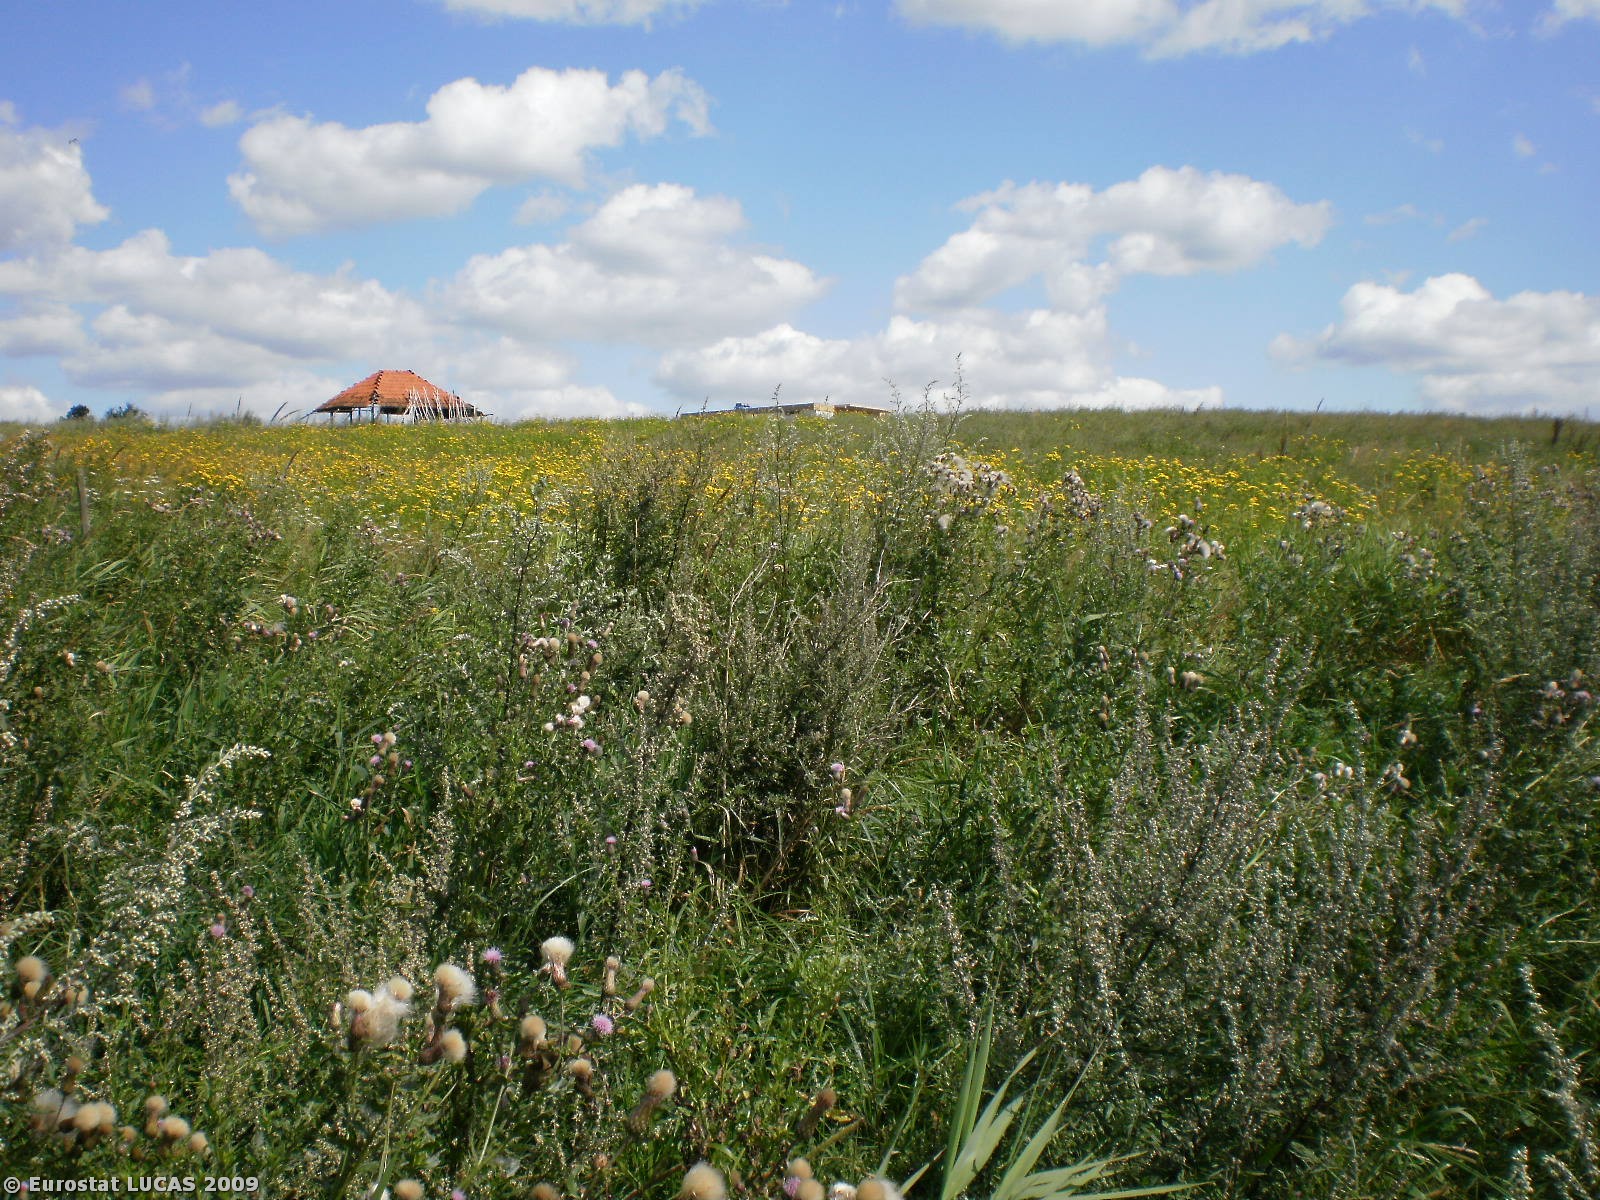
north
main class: Cropland
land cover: Triticale
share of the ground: > 75 %
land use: Agriculture (excluding fallow land and kitchen gardens)
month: August
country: PL
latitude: 53.8803
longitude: 20.5796
